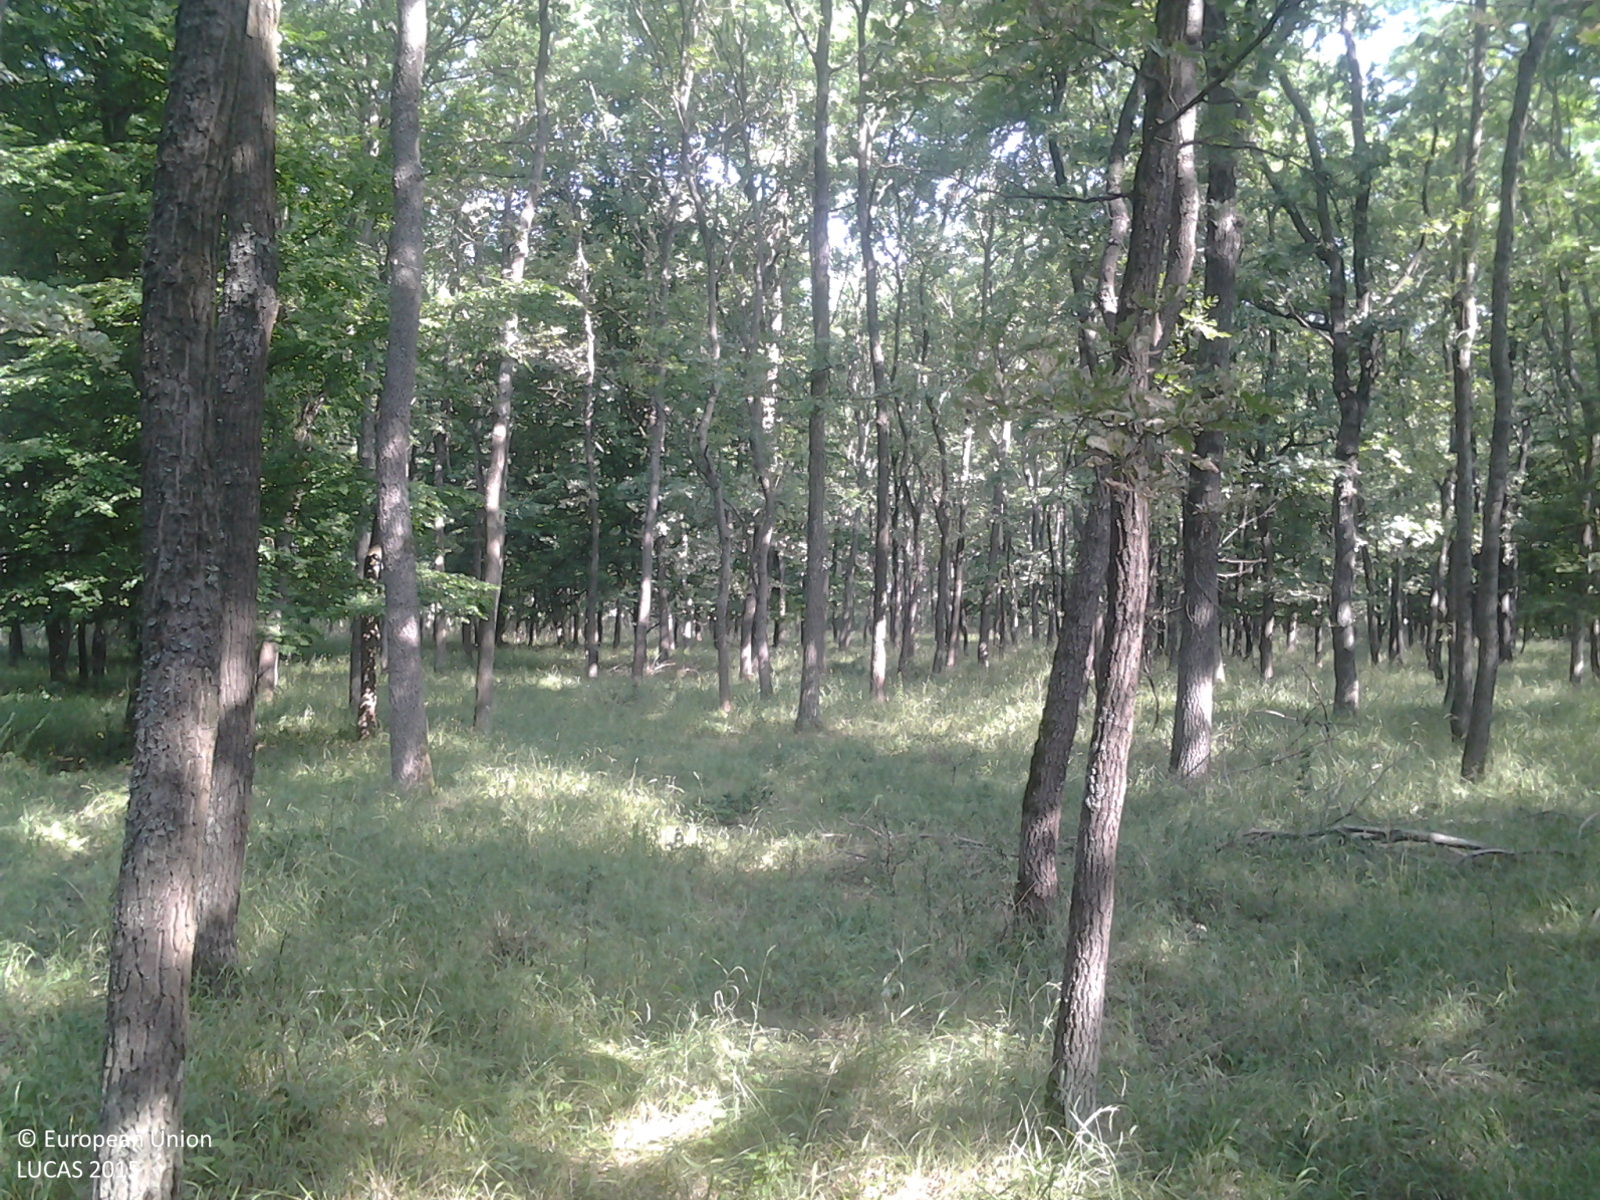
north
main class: Woodland
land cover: Broadleaved woodland
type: mesophytic deciduous forest
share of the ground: > 75 %
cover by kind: broadleaved forest trees 90 %, herbaceous plants 10 %
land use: Forestry
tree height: > 5 m
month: July
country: HU
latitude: 46.6617
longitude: 21.4472
